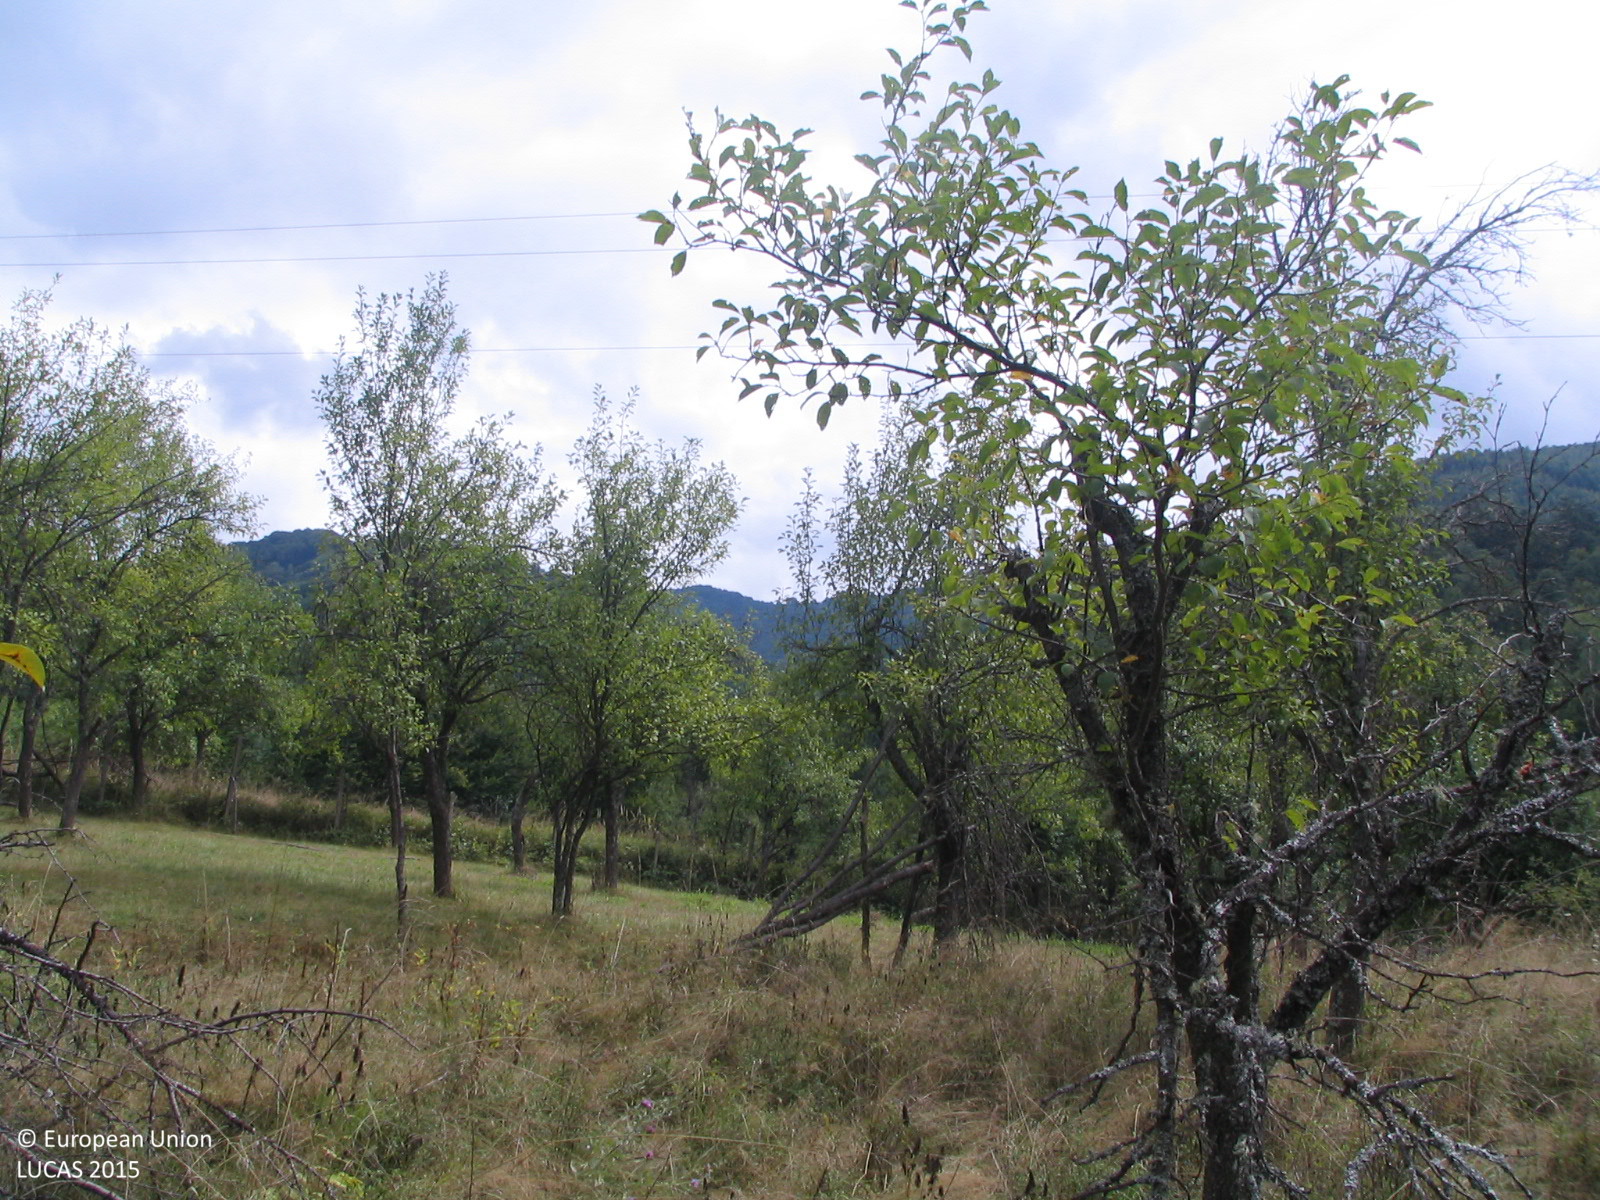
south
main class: Cropland
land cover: Other fruit trees and berries
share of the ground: 50 - 75 %
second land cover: Grassland without tree/shrub cover
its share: > 75 %
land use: Agriculture (excluding fallow land and kitchen gardens)
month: August
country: BG
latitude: 42.8704
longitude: 24.7364
